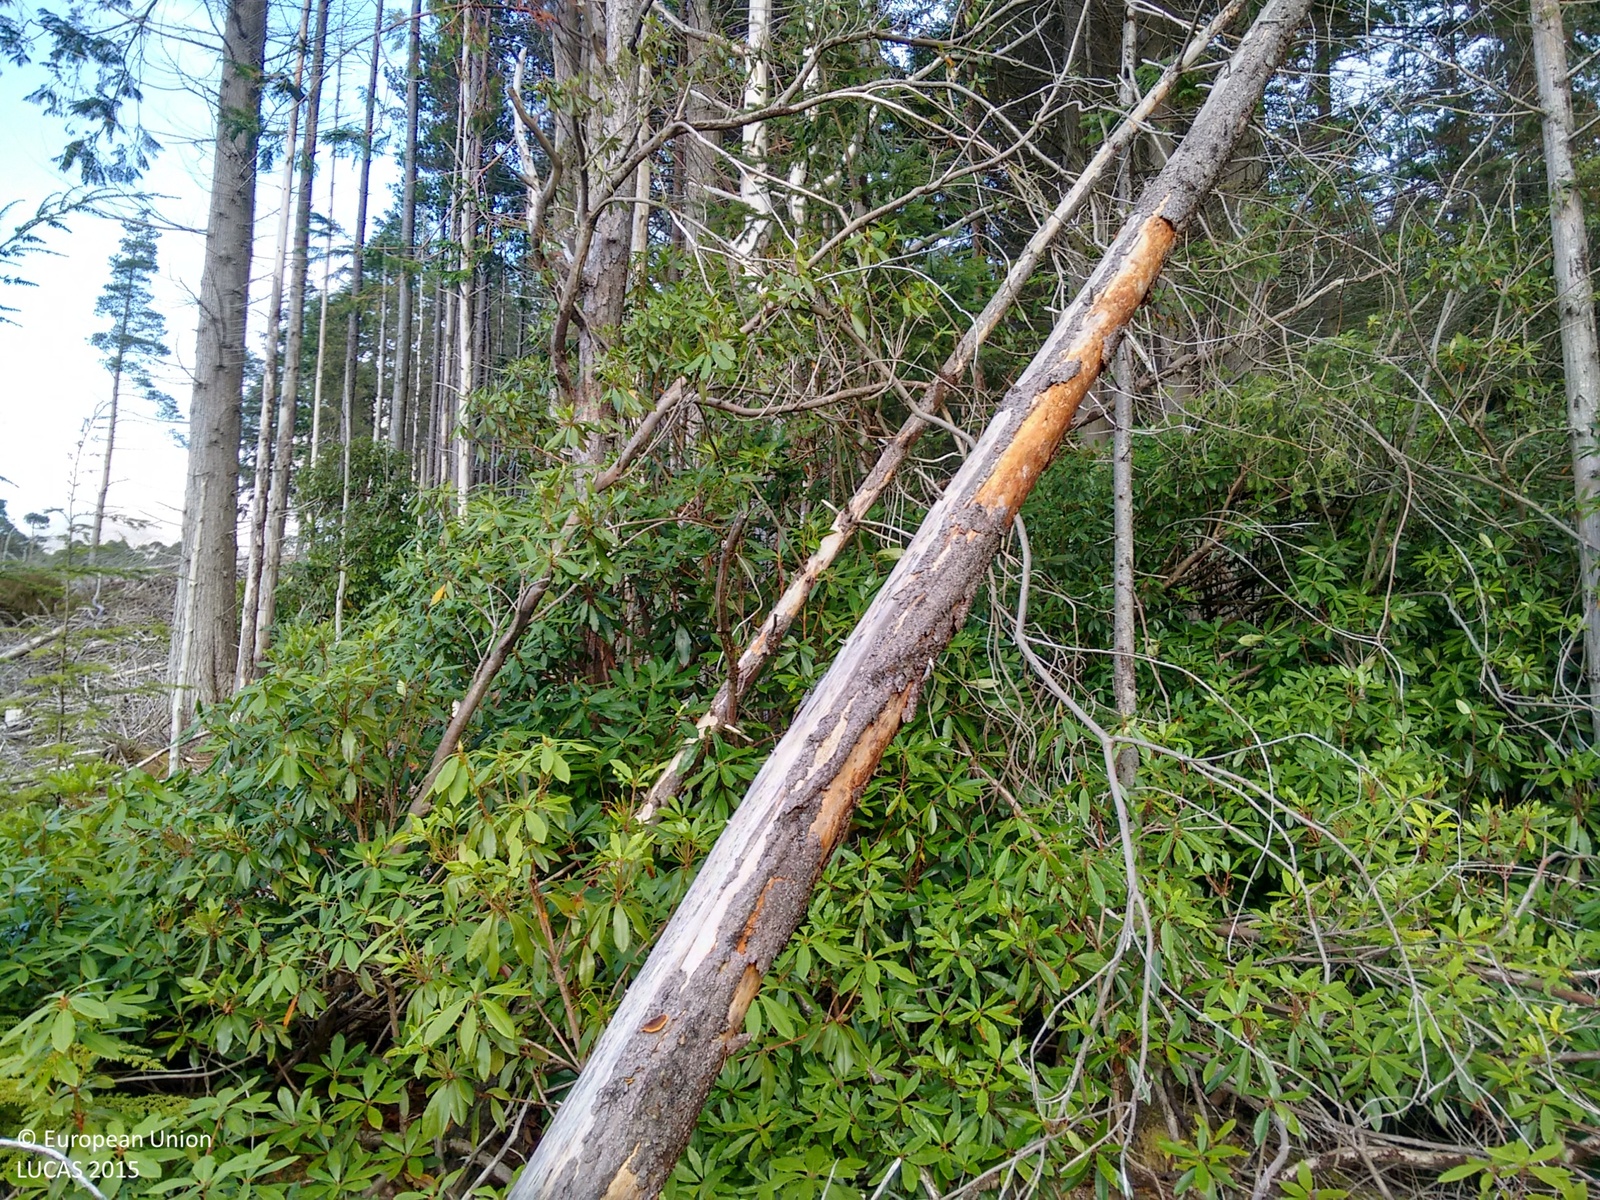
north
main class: Woodland
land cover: Spruce dominated mixed woodland
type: exotic forest
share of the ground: 50 - 75 %
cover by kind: coniferous forest trees 40 %, broadleaved forest trees 25 %, unconsolidated bare surface 25 %, shrubs 5 %, herbaceous plants 5 %
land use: Forestry
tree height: > 5 m
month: November
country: GB
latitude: 57.4781
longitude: -5.3373
